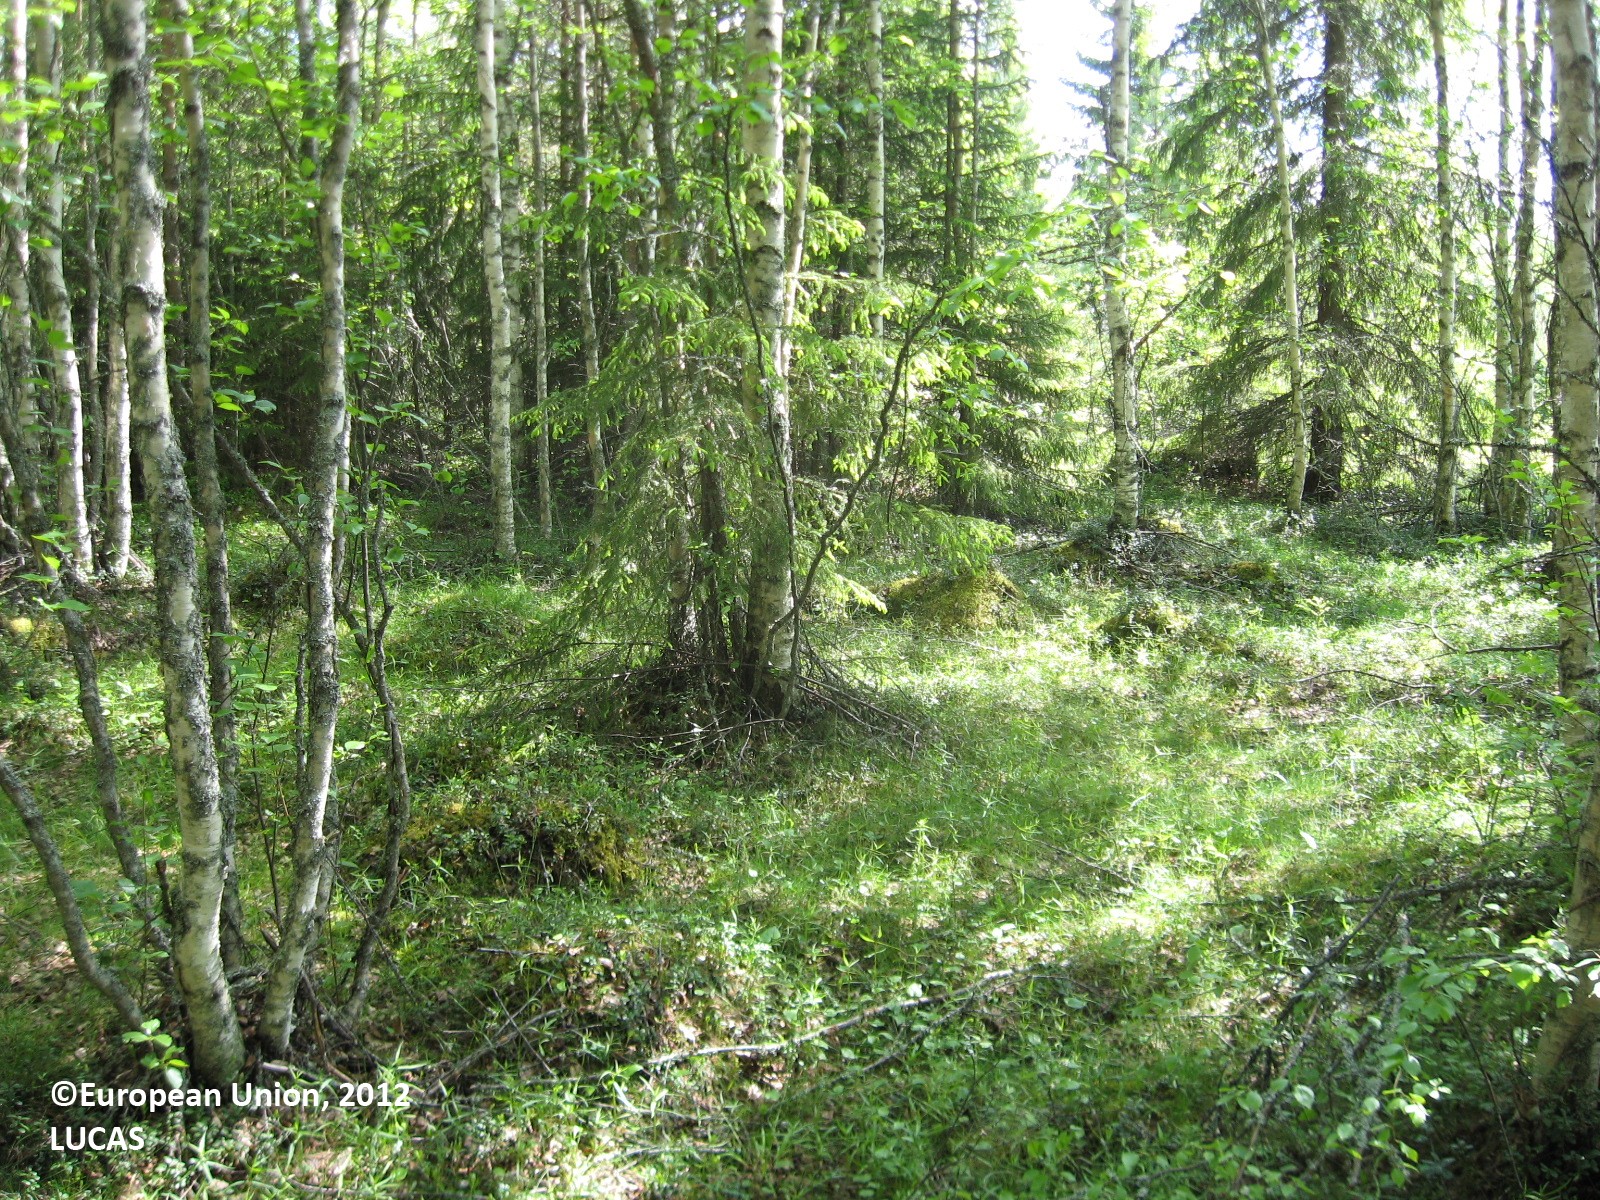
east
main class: Woodland
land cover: Broadleaved woodland
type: boreal forest
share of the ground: > 75 %
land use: Forestry
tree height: > 5 m
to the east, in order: Broadleaved woodland; Spruce dominated mixed woodland; Pine dominated coniferous woodland; Ditches and canals; Spruce dominated mixed woodland; Pine dominated coniferous woodland; Ditches and canals; Pine dominated coniferous woodland; Ditches and canals; Pine dominated mixed woodland; Other mixed woodland
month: June
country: FI
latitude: 63.1503
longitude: 22.0512
